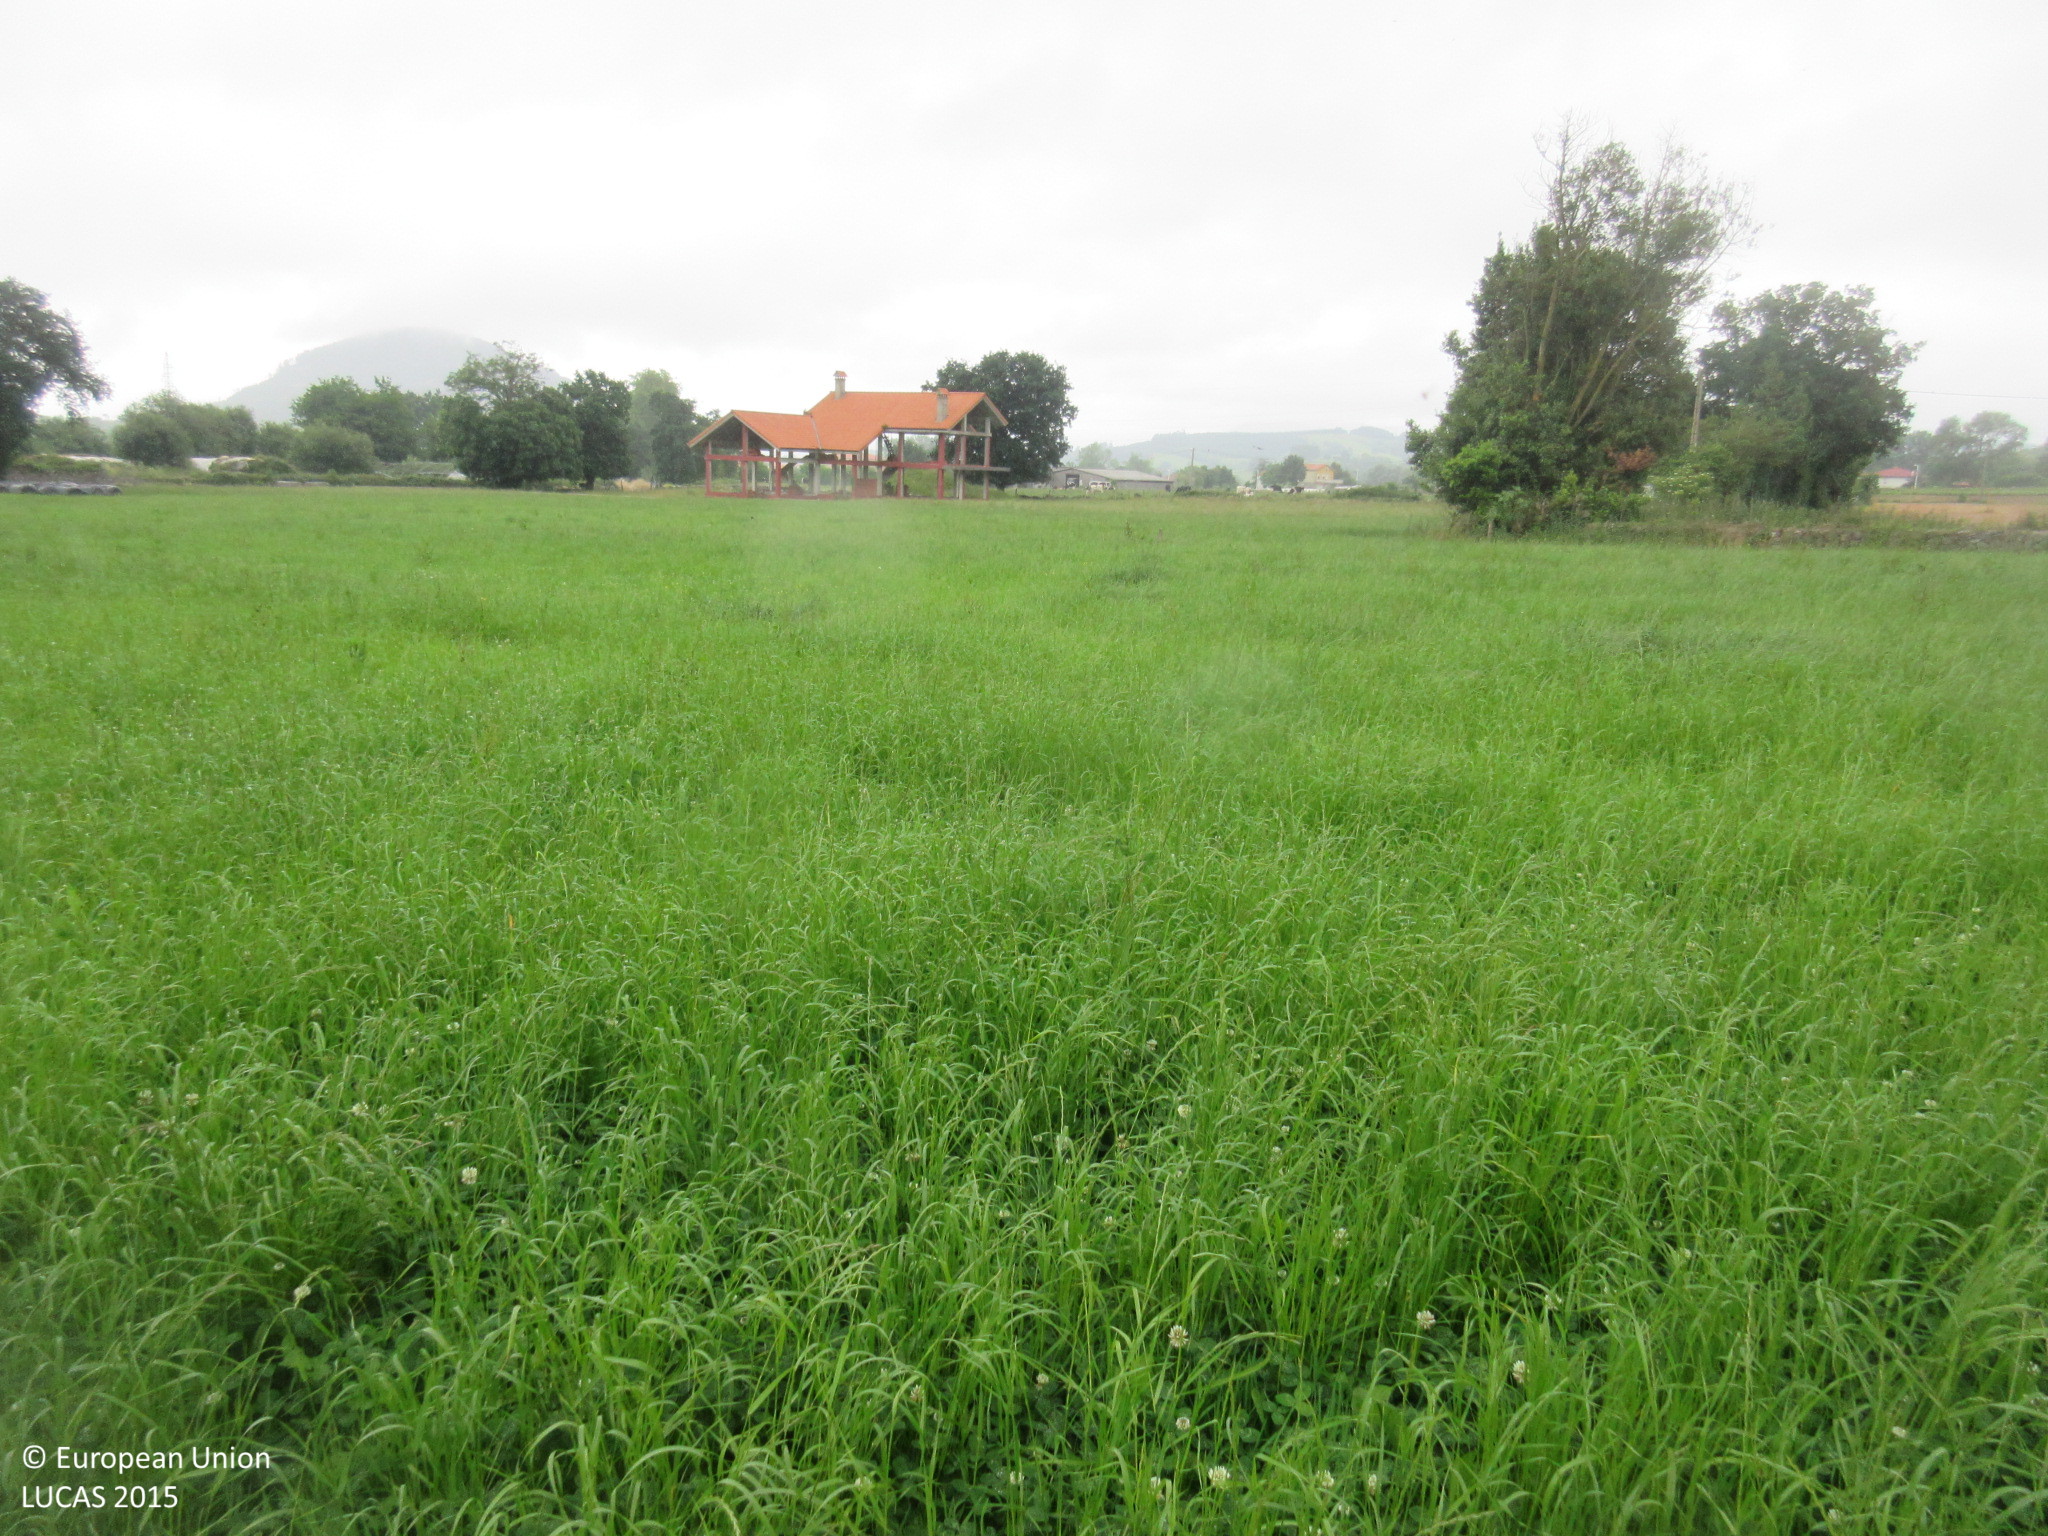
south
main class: Cropland
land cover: Temporary grasslands
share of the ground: > 75 %
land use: Agriculture (excluding fallow land and kitchen gardens)
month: June
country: ES
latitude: 43.4422
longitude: -3.5245
